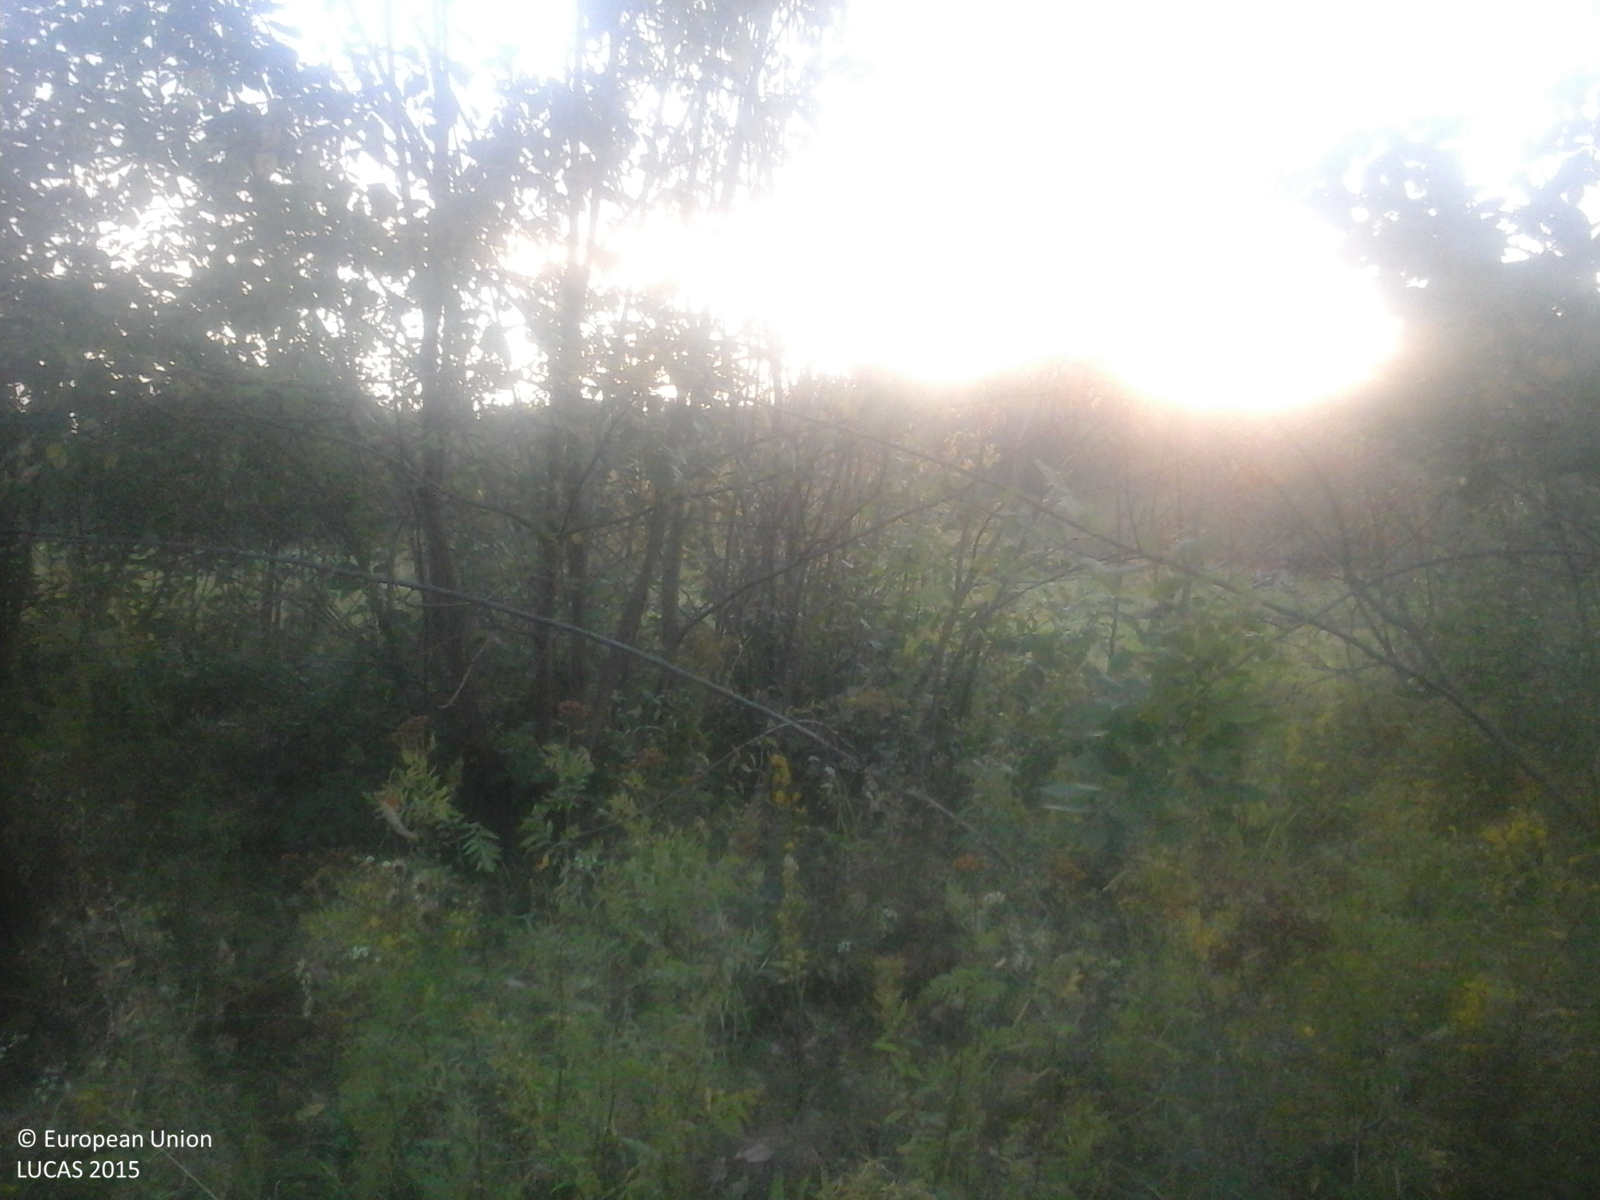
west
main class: Grassland
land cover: Grassland with sparse tree/shrub cover
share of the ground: > 75 %
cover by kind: herbaceous plants 85 %, shrubs 10 %, broadleaved forest trees 5 %
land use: Agriculture (excluding fallow land and kitchen gardens)
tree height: < 5 m
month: September
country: RO
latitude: 47.6547
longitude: 24.2693
